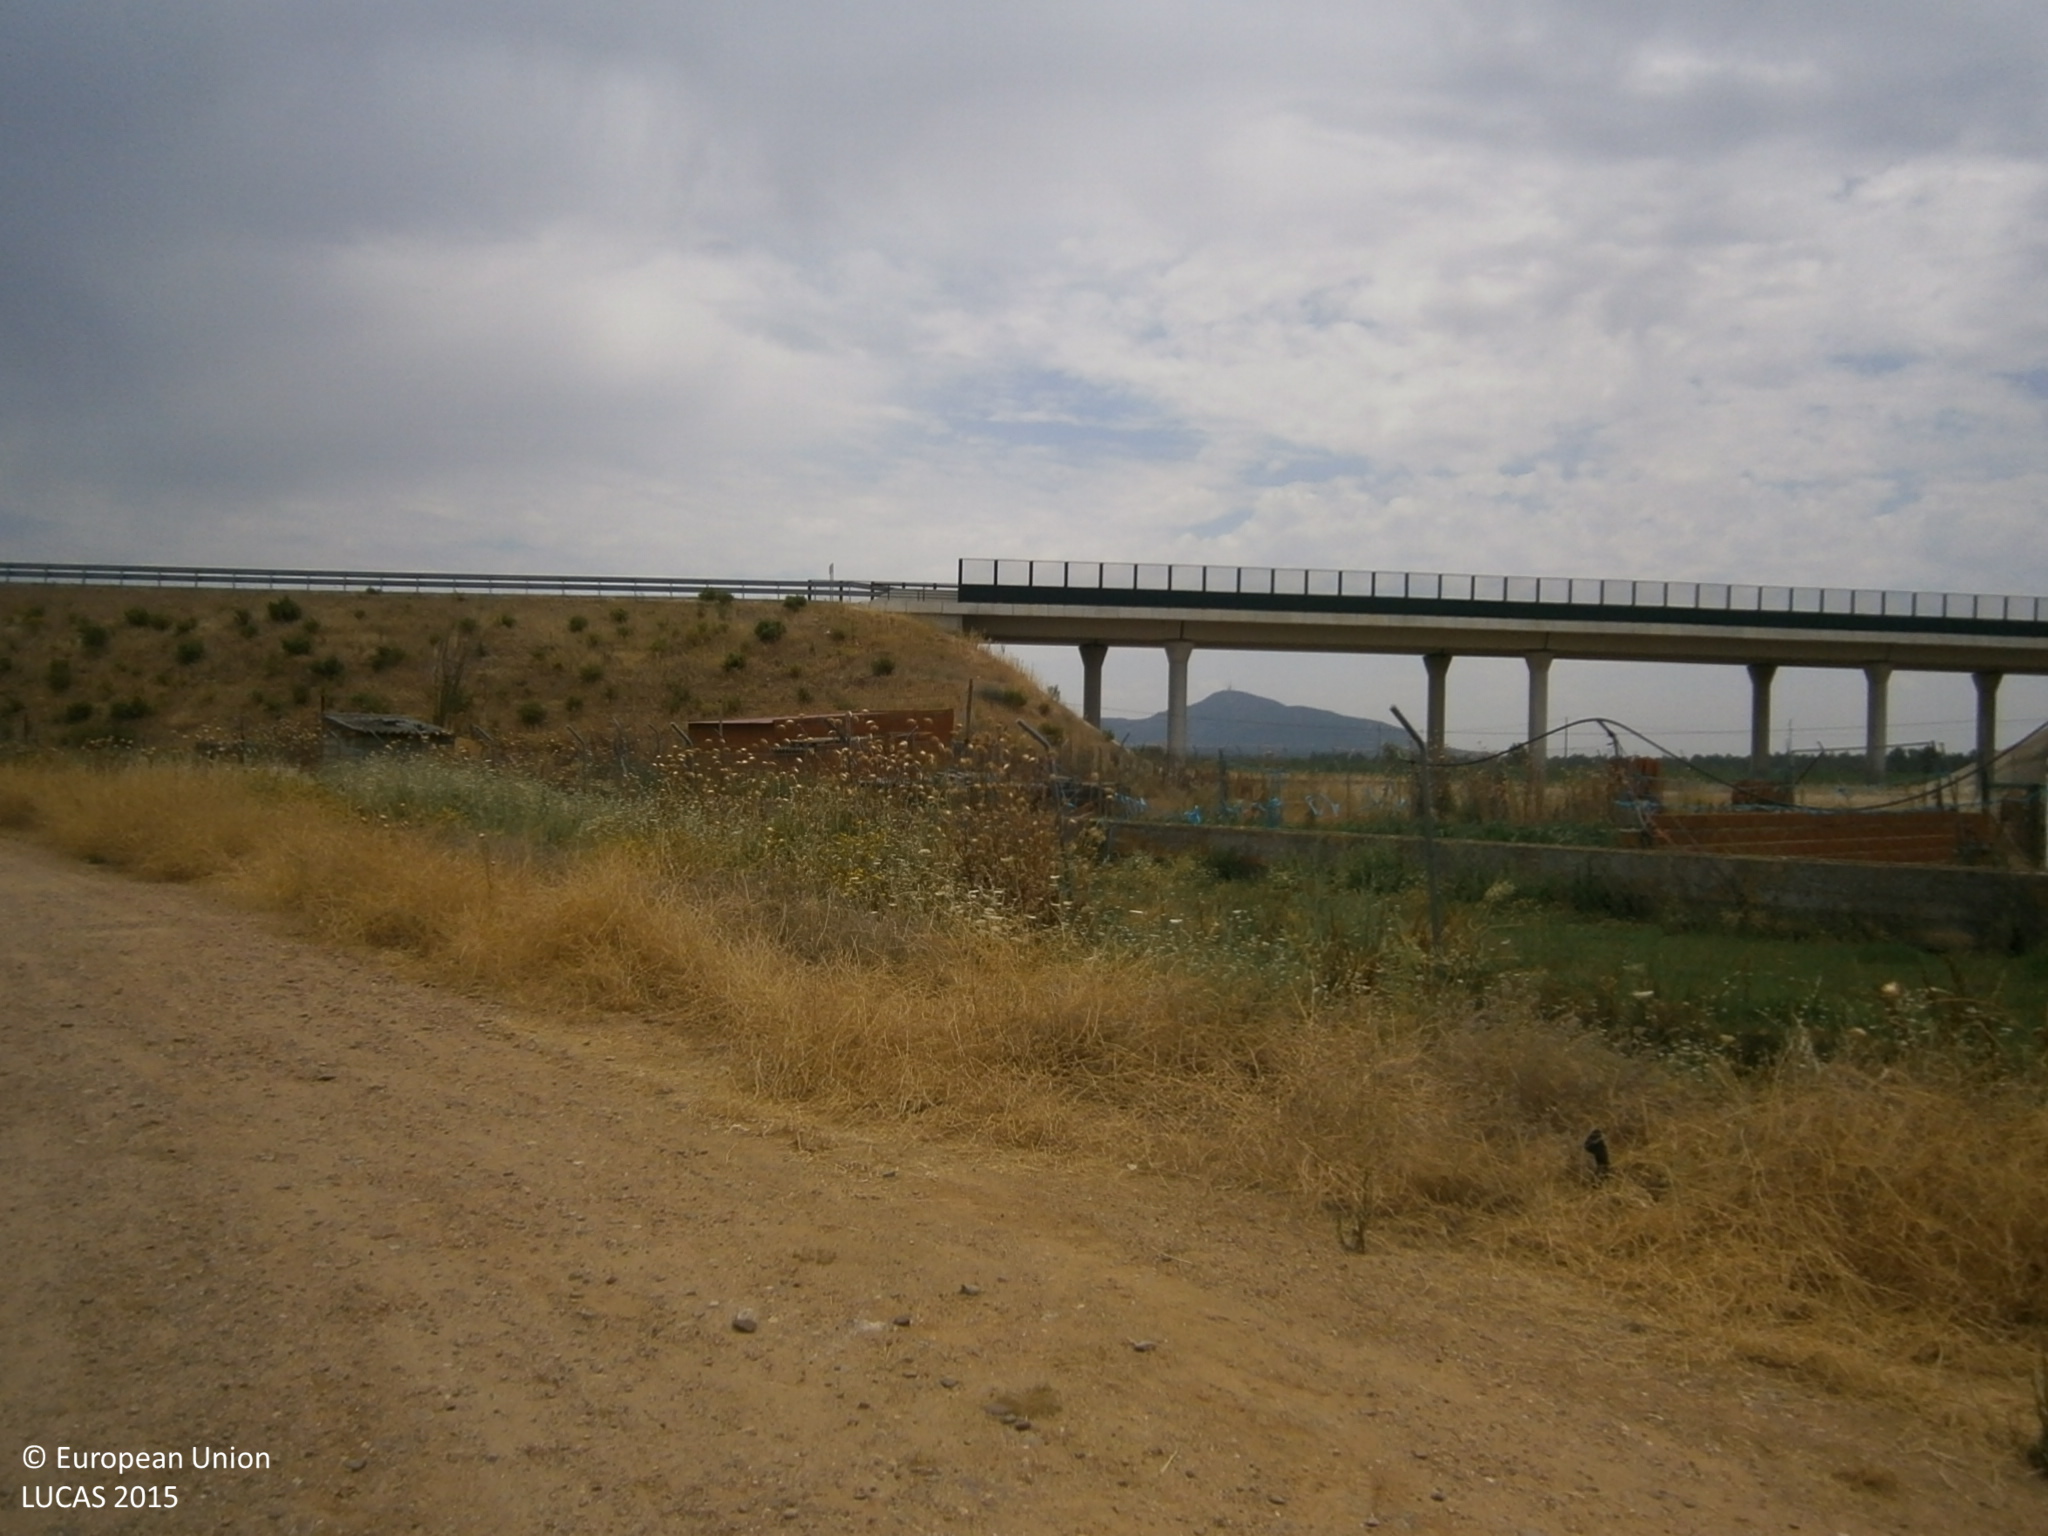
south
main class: Grassland
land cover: Grassland without tree/shrub cover
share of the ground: 25 - 50 %
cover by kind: herbaceous plants 95 %, shrubs 5 %
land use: Abandoned areas
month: June
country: ES
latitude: 38.9155
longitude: -6.4952
